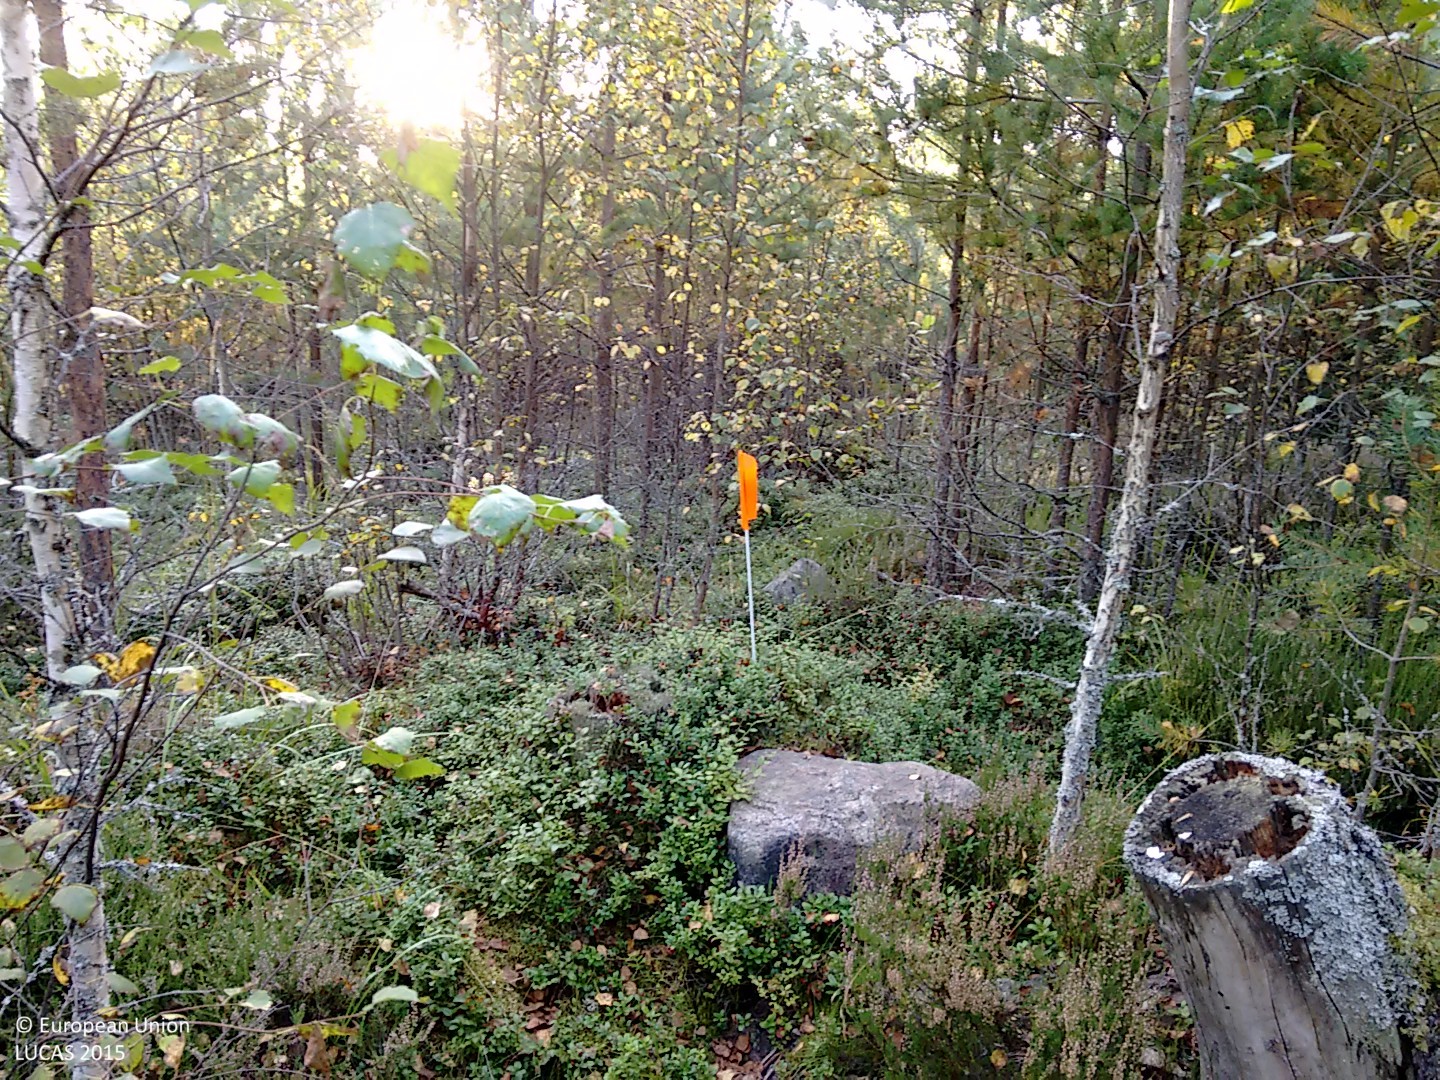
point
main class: Woodland
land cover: Spruce dominated mixed woodland
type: hemiboreal forest and nemoral coniferous forest and mixed broadleaved-coniferous forest
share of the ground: > 75 %
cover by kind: coniferous forest trees 60 %, broadleaved forest trees 30 %, shrubs 5 %, herbaceous plants 5 %
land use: Forestry
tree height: > 5 m
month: September
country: FI
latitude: 60.9761
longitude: 21.6032
